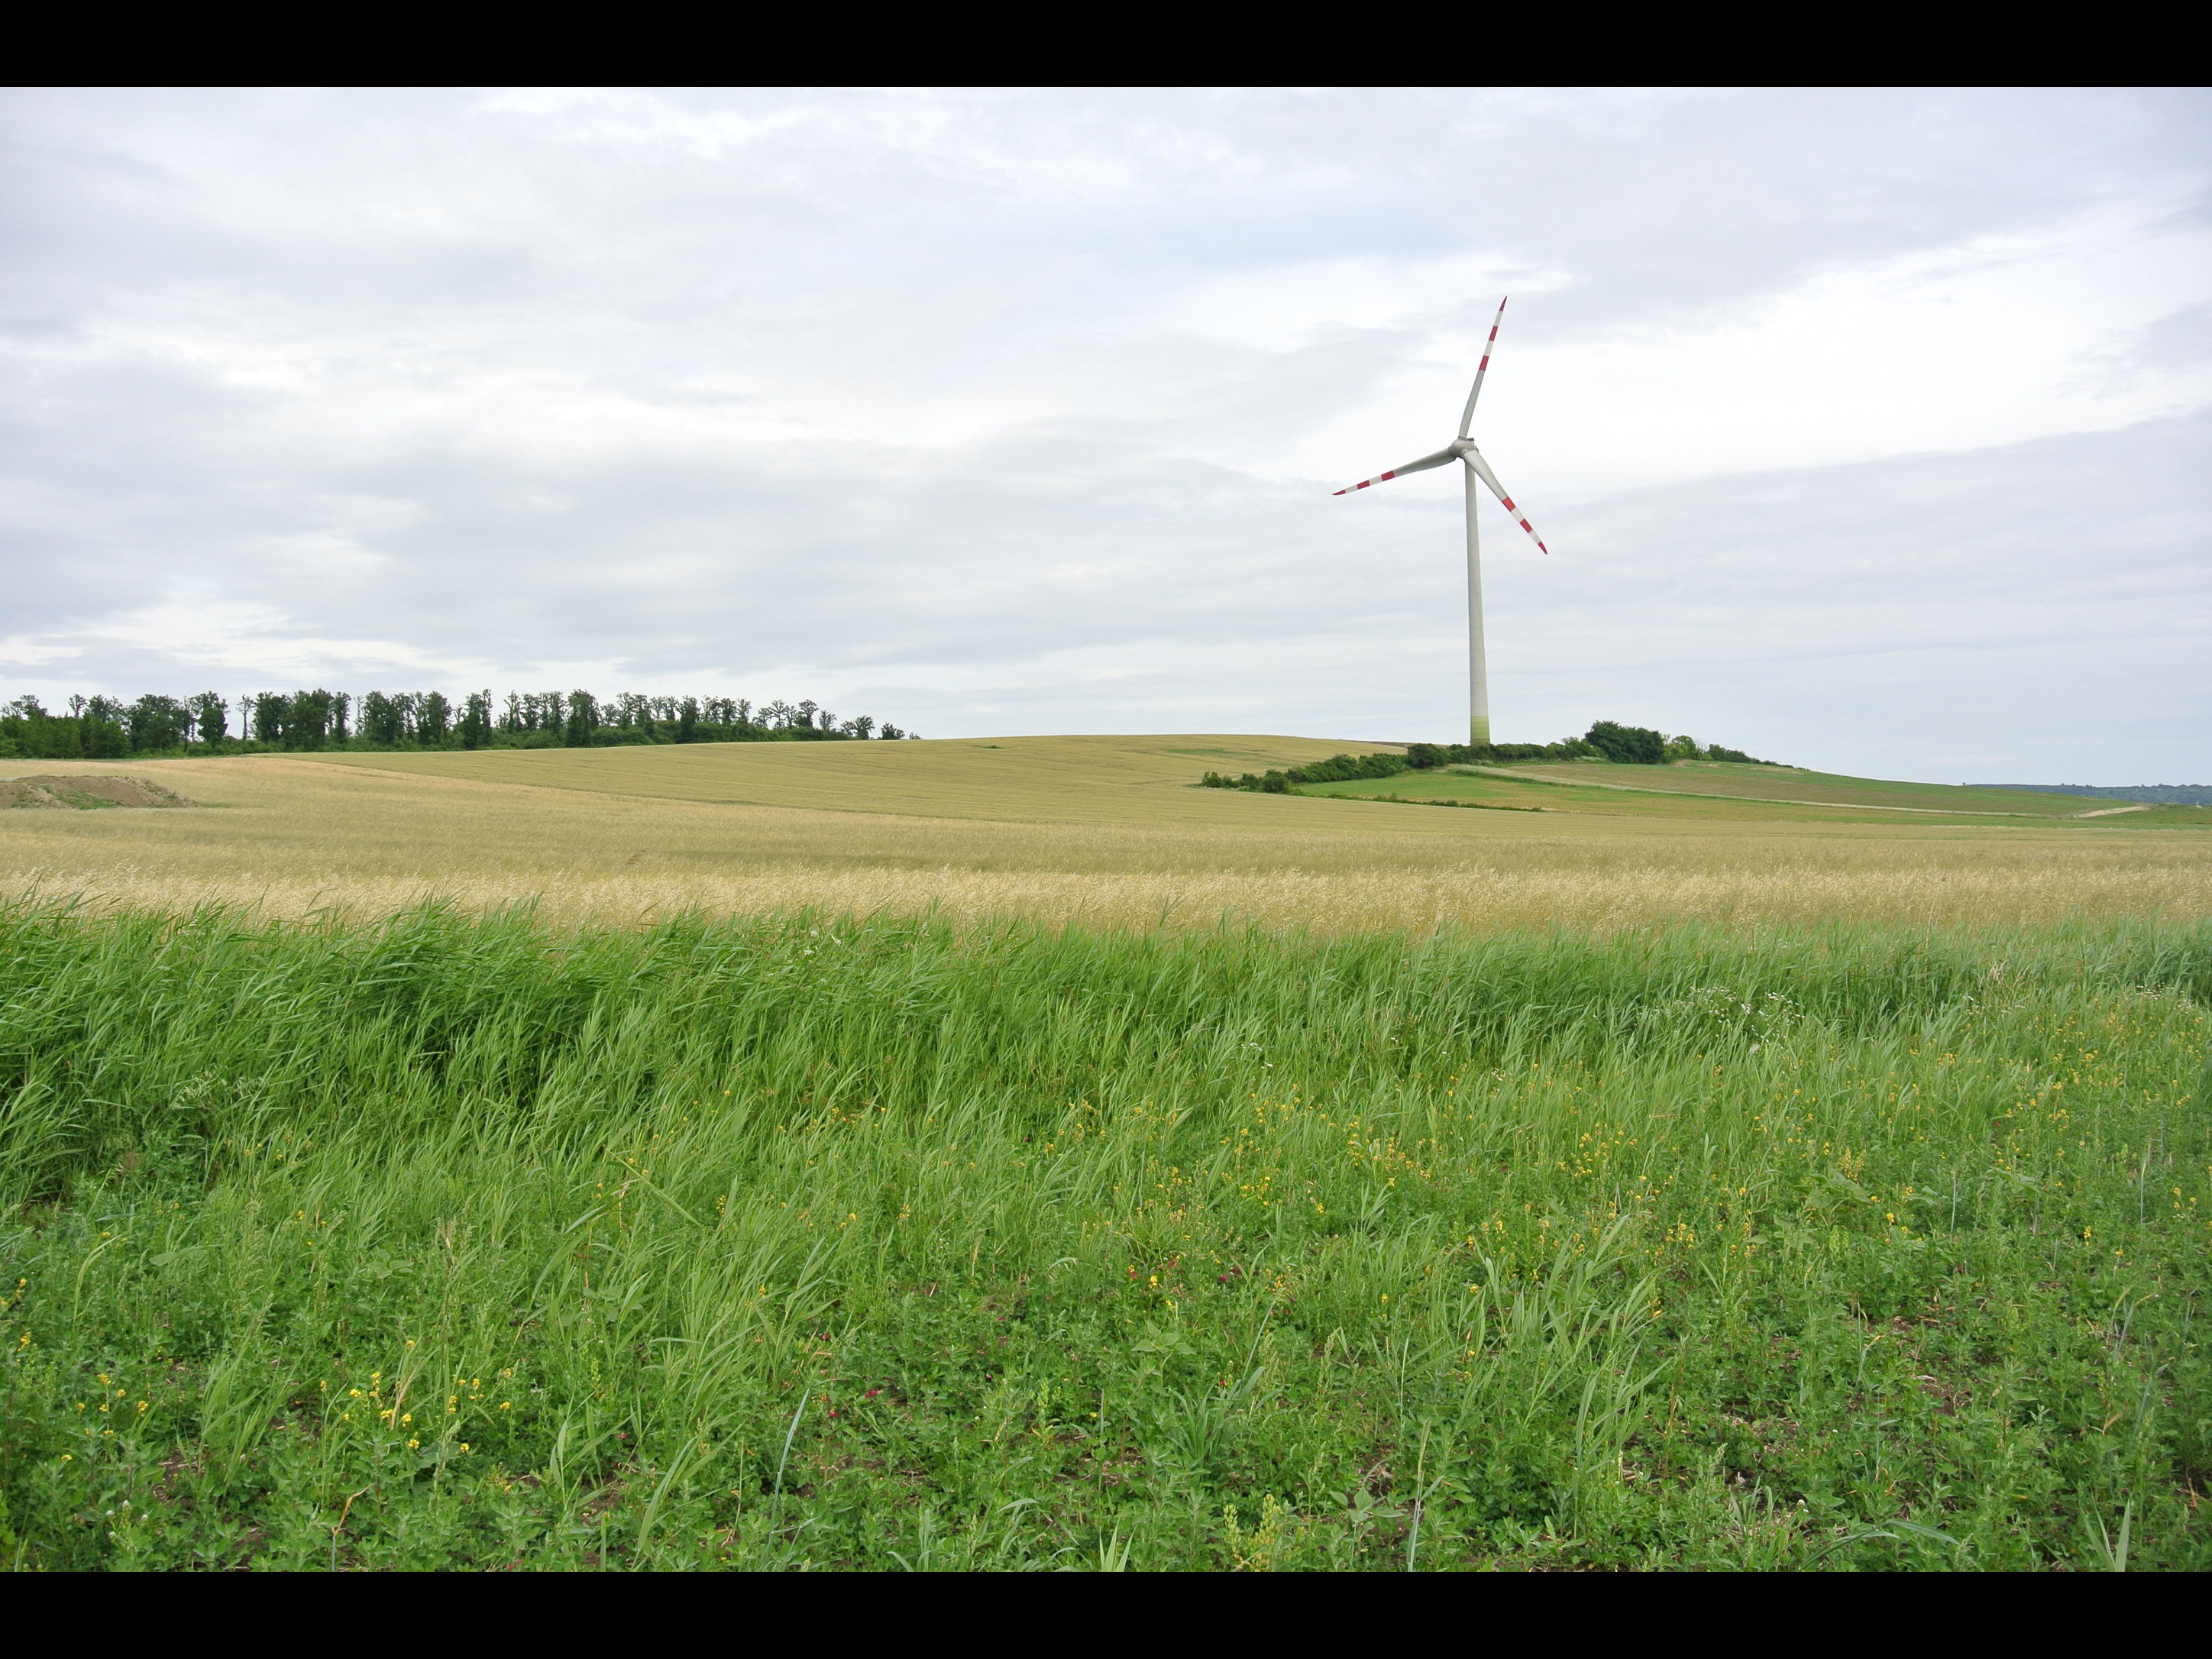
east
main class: Cropland
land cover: Other leguminous and mixtures for fodder
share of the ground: > 75 %
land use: Agriculture (excluding fallow land and kitchen gardens)
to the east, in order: Other leguminous and mixtures for fodder; Ditches and canals; Inland marshes; Oats
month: June
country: AT
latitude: 47.7413
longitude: 16.5259
